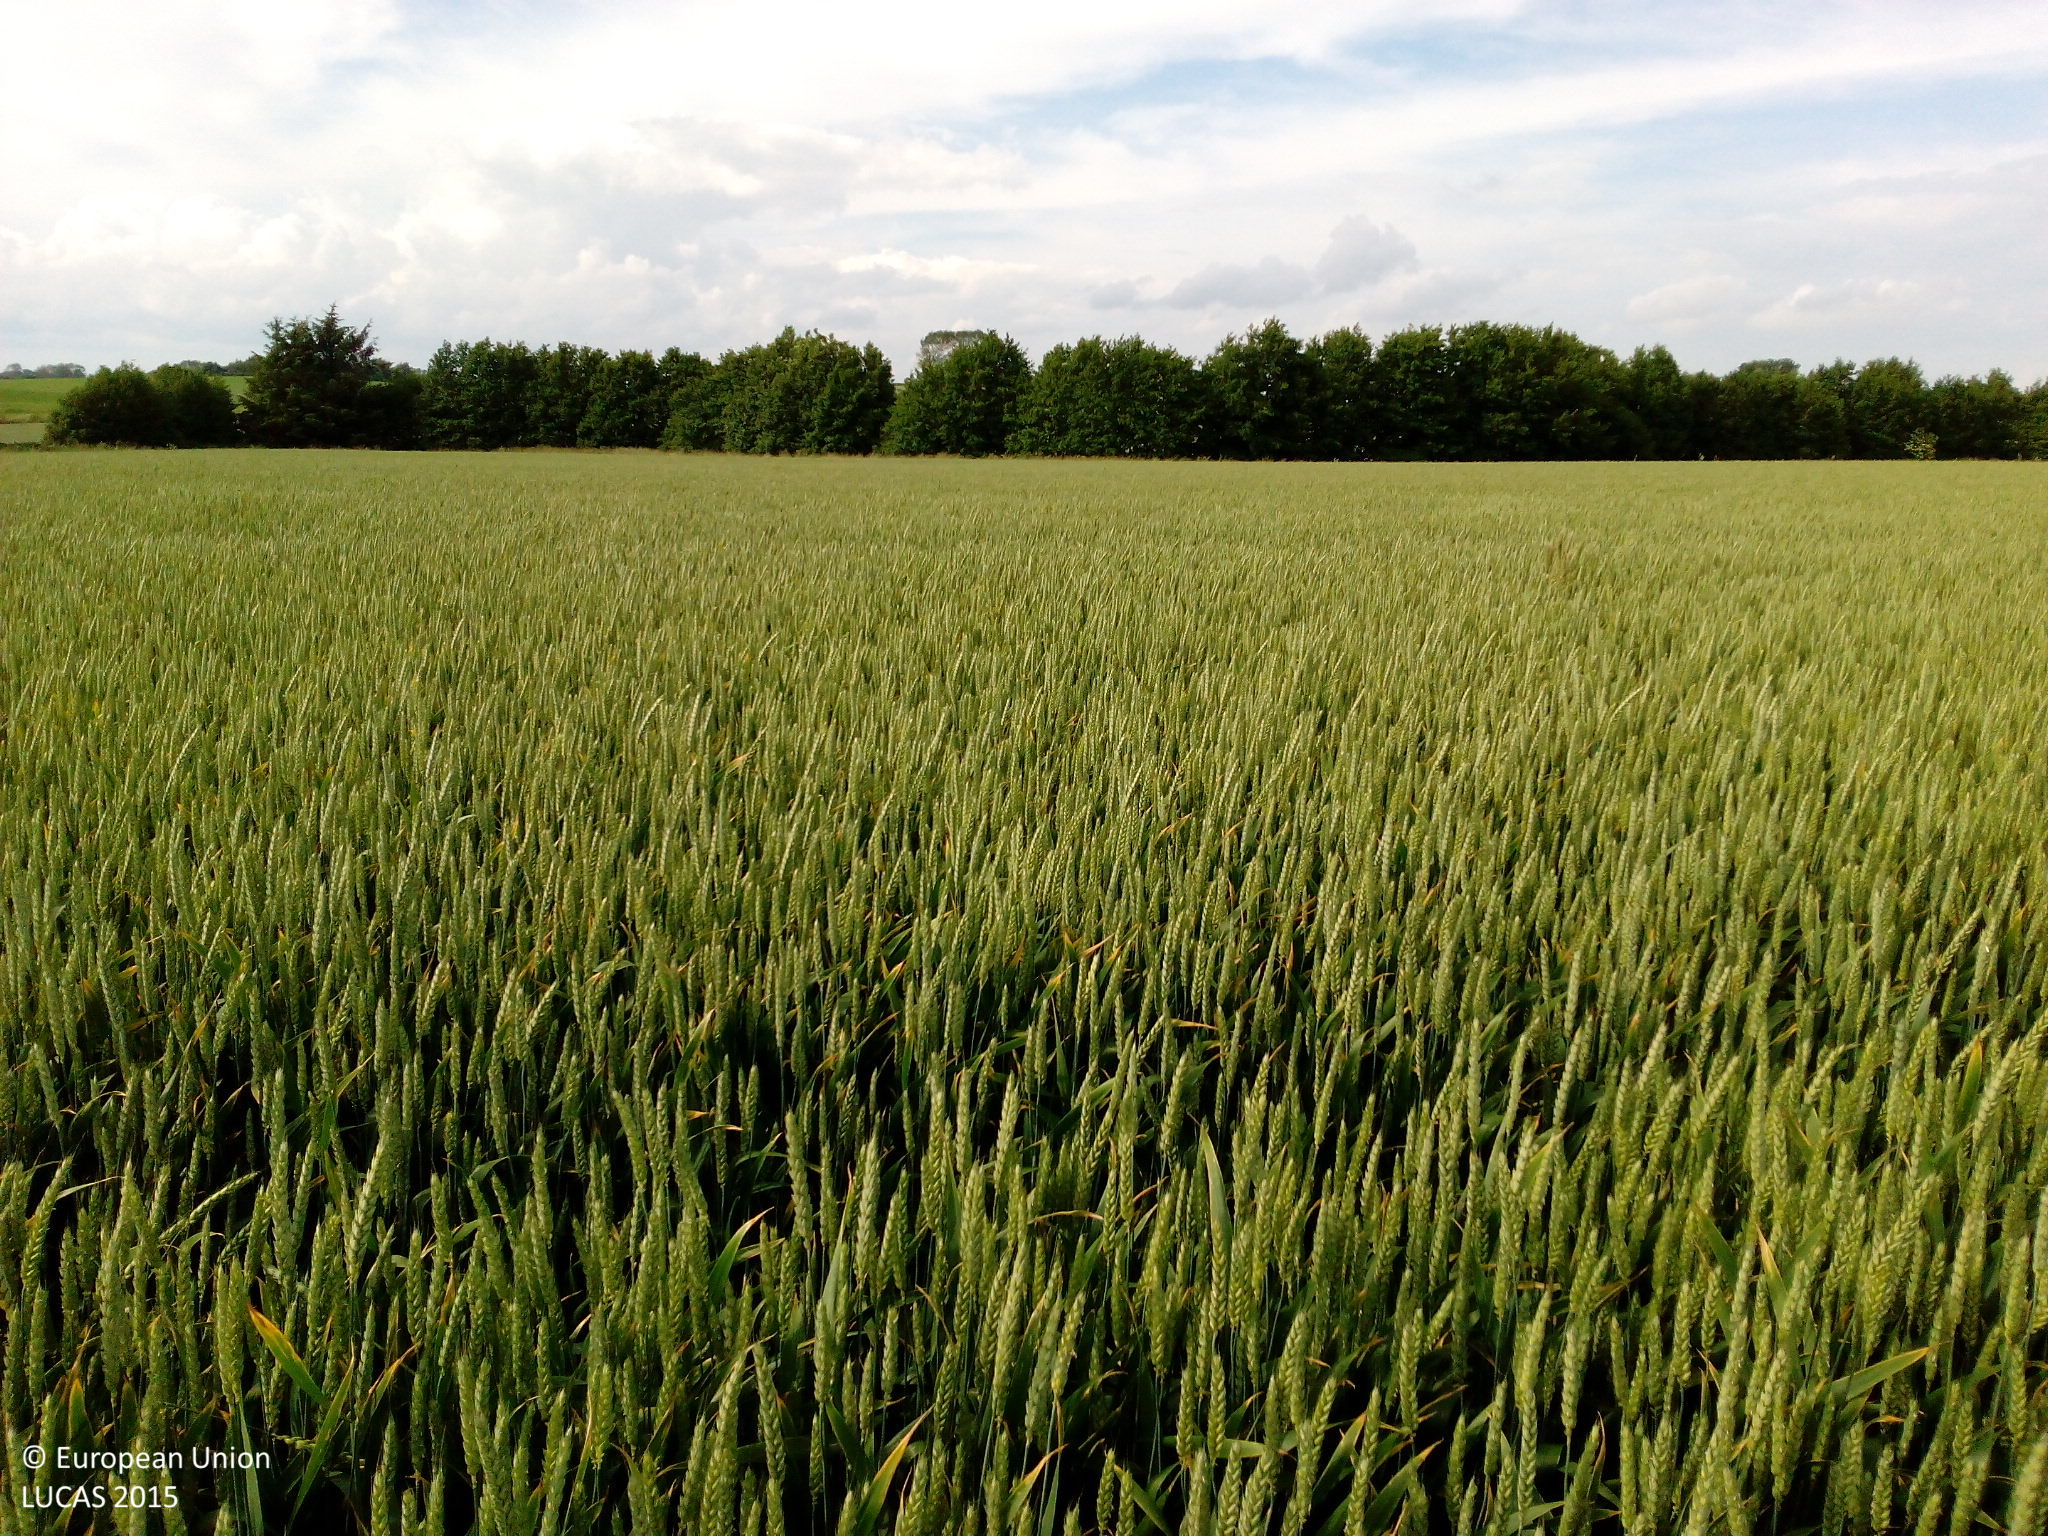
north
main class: Cropland
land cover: Common wheat
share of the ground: > 75 %
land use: Agriculture (excluding fallow land and kitchen gardens)
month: June
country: DK
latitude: 55.0950
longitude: 11.8947
